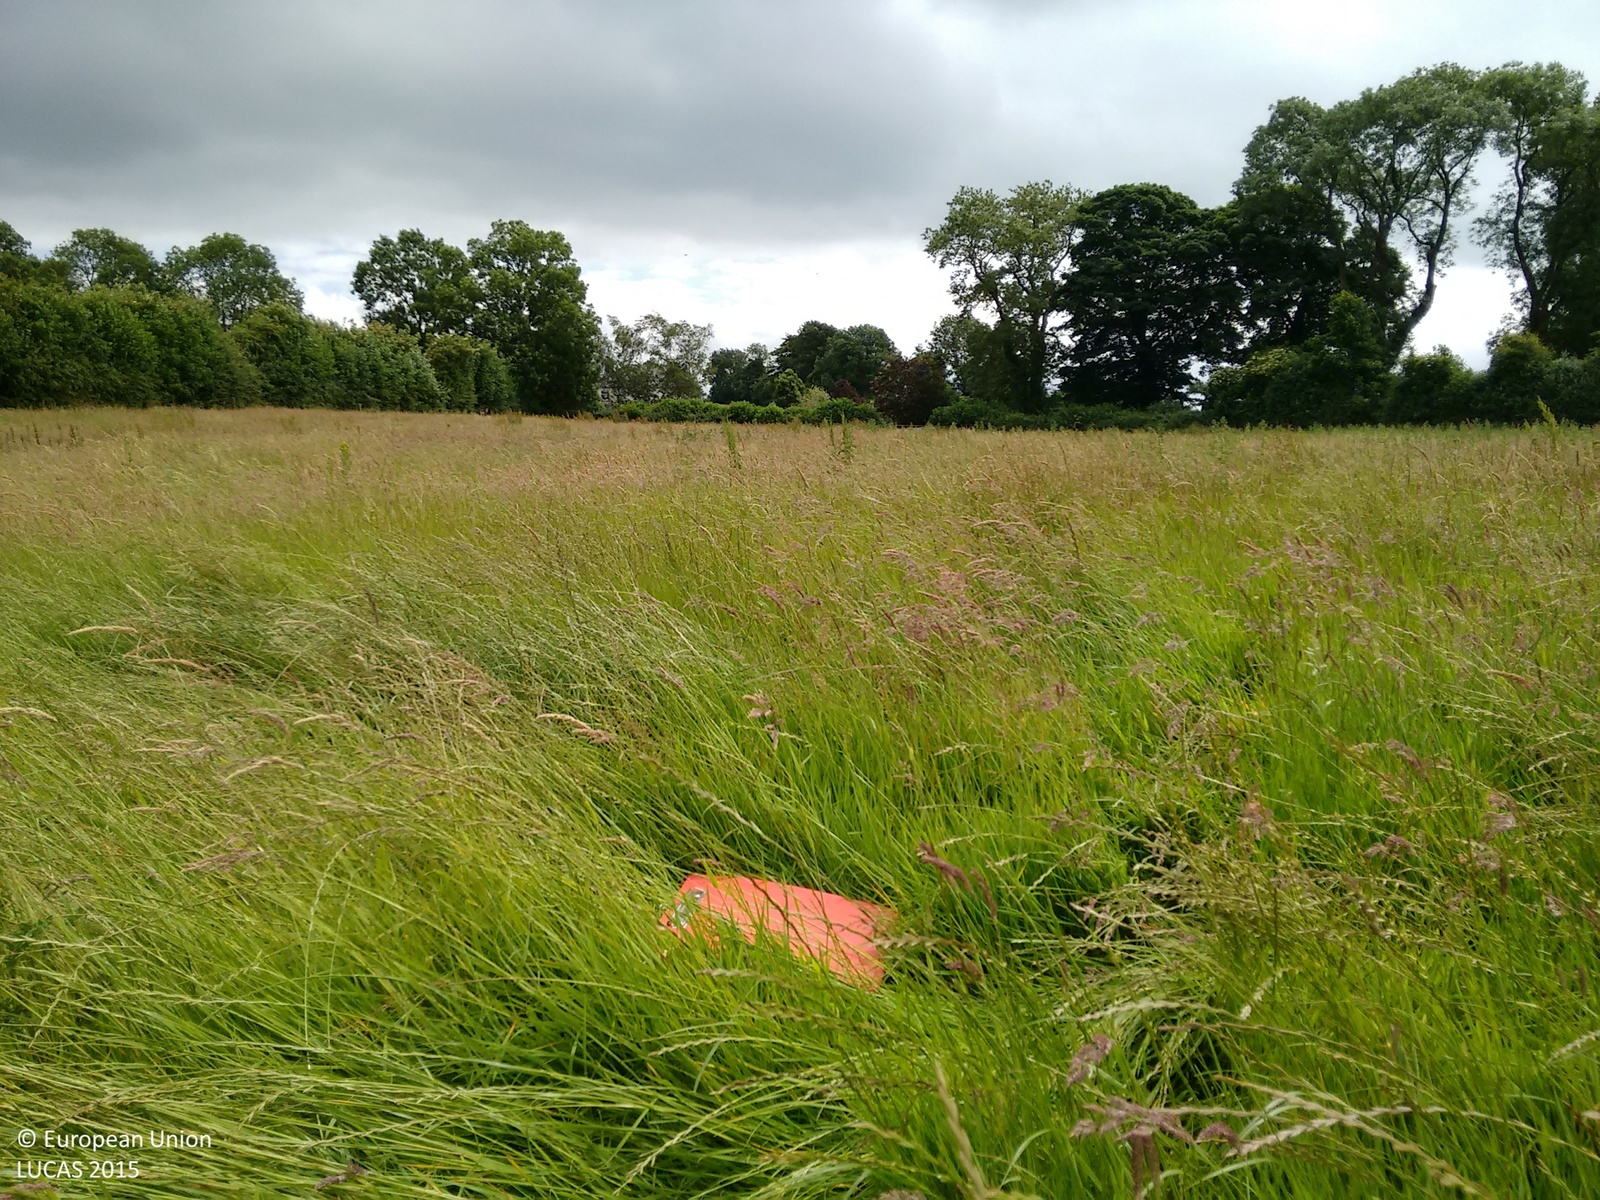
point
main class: Grassland
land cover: Grassland without tree/shrub cover
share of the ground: > 75 %
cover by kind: herbaceous plants 100 %
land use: Agriculture (excluding fallow land and kitchen gardens)
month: July
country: IE
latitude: 52.9484
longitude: -6.8207
